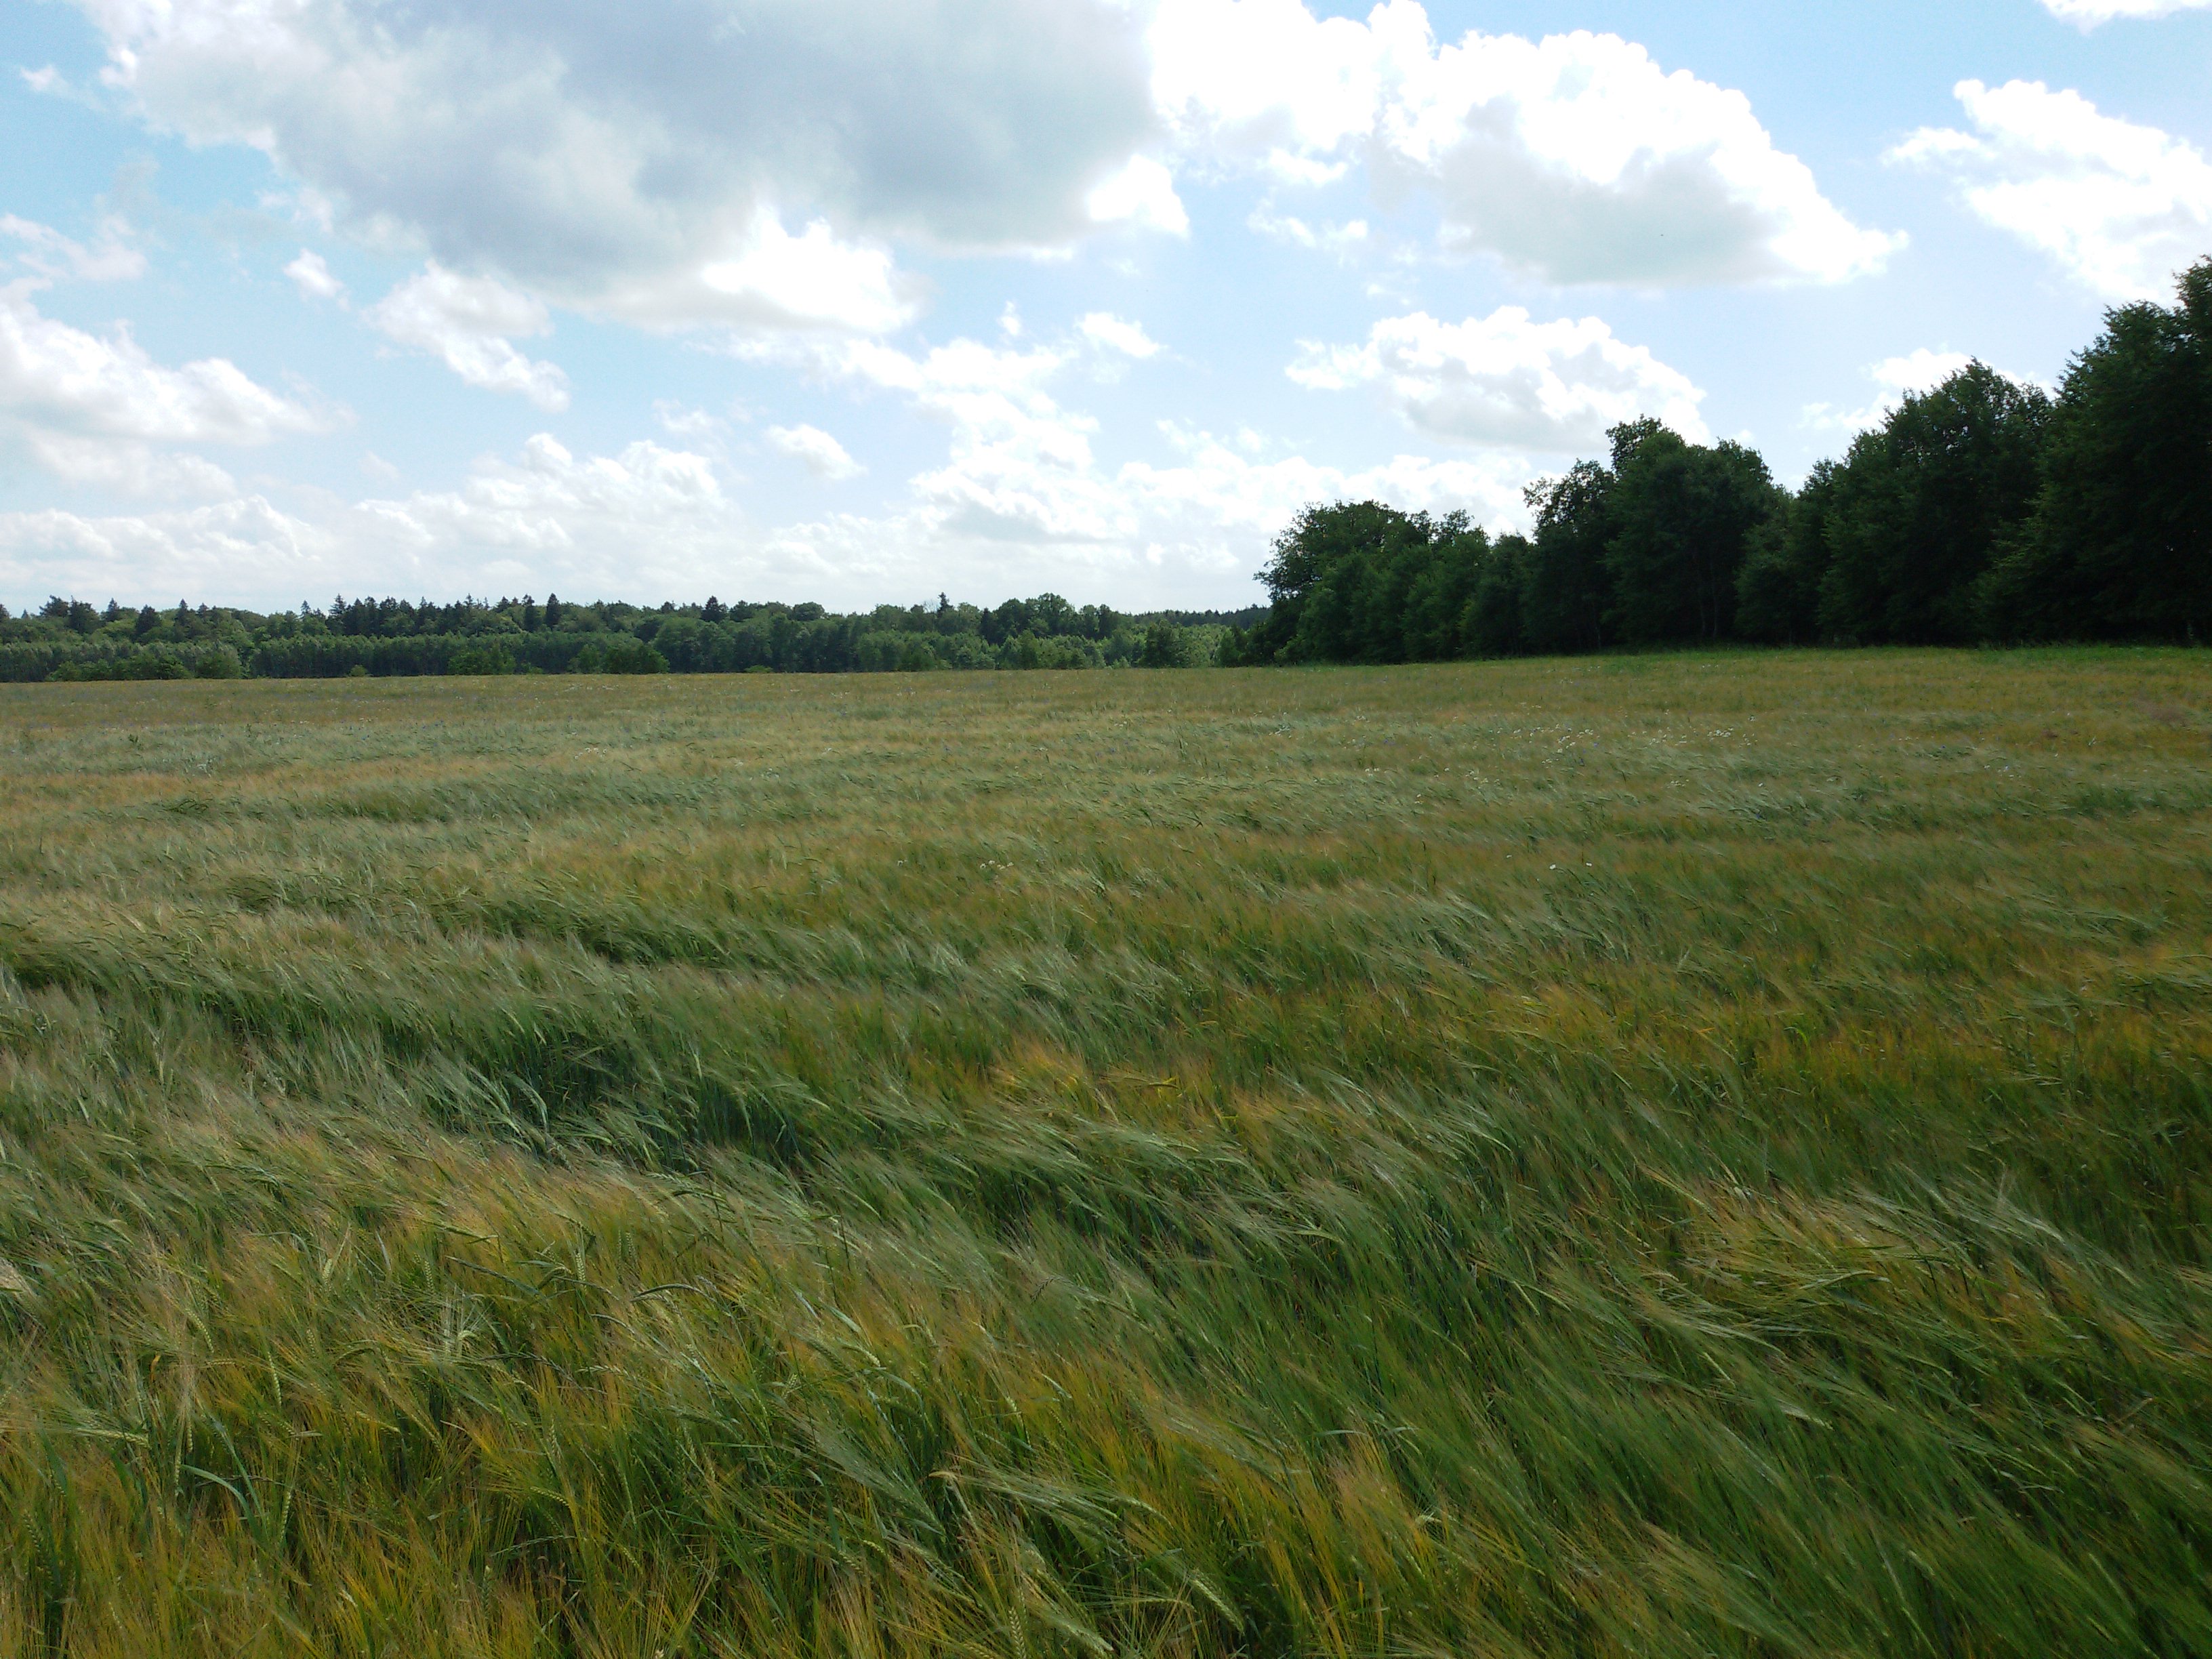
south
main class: Cropland
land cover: Barley
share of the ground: > 75 %
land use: Agriculture (excluding fallow land and kitchen gardens)
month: July
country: PL
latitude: 54.1594
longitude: 15.8999
